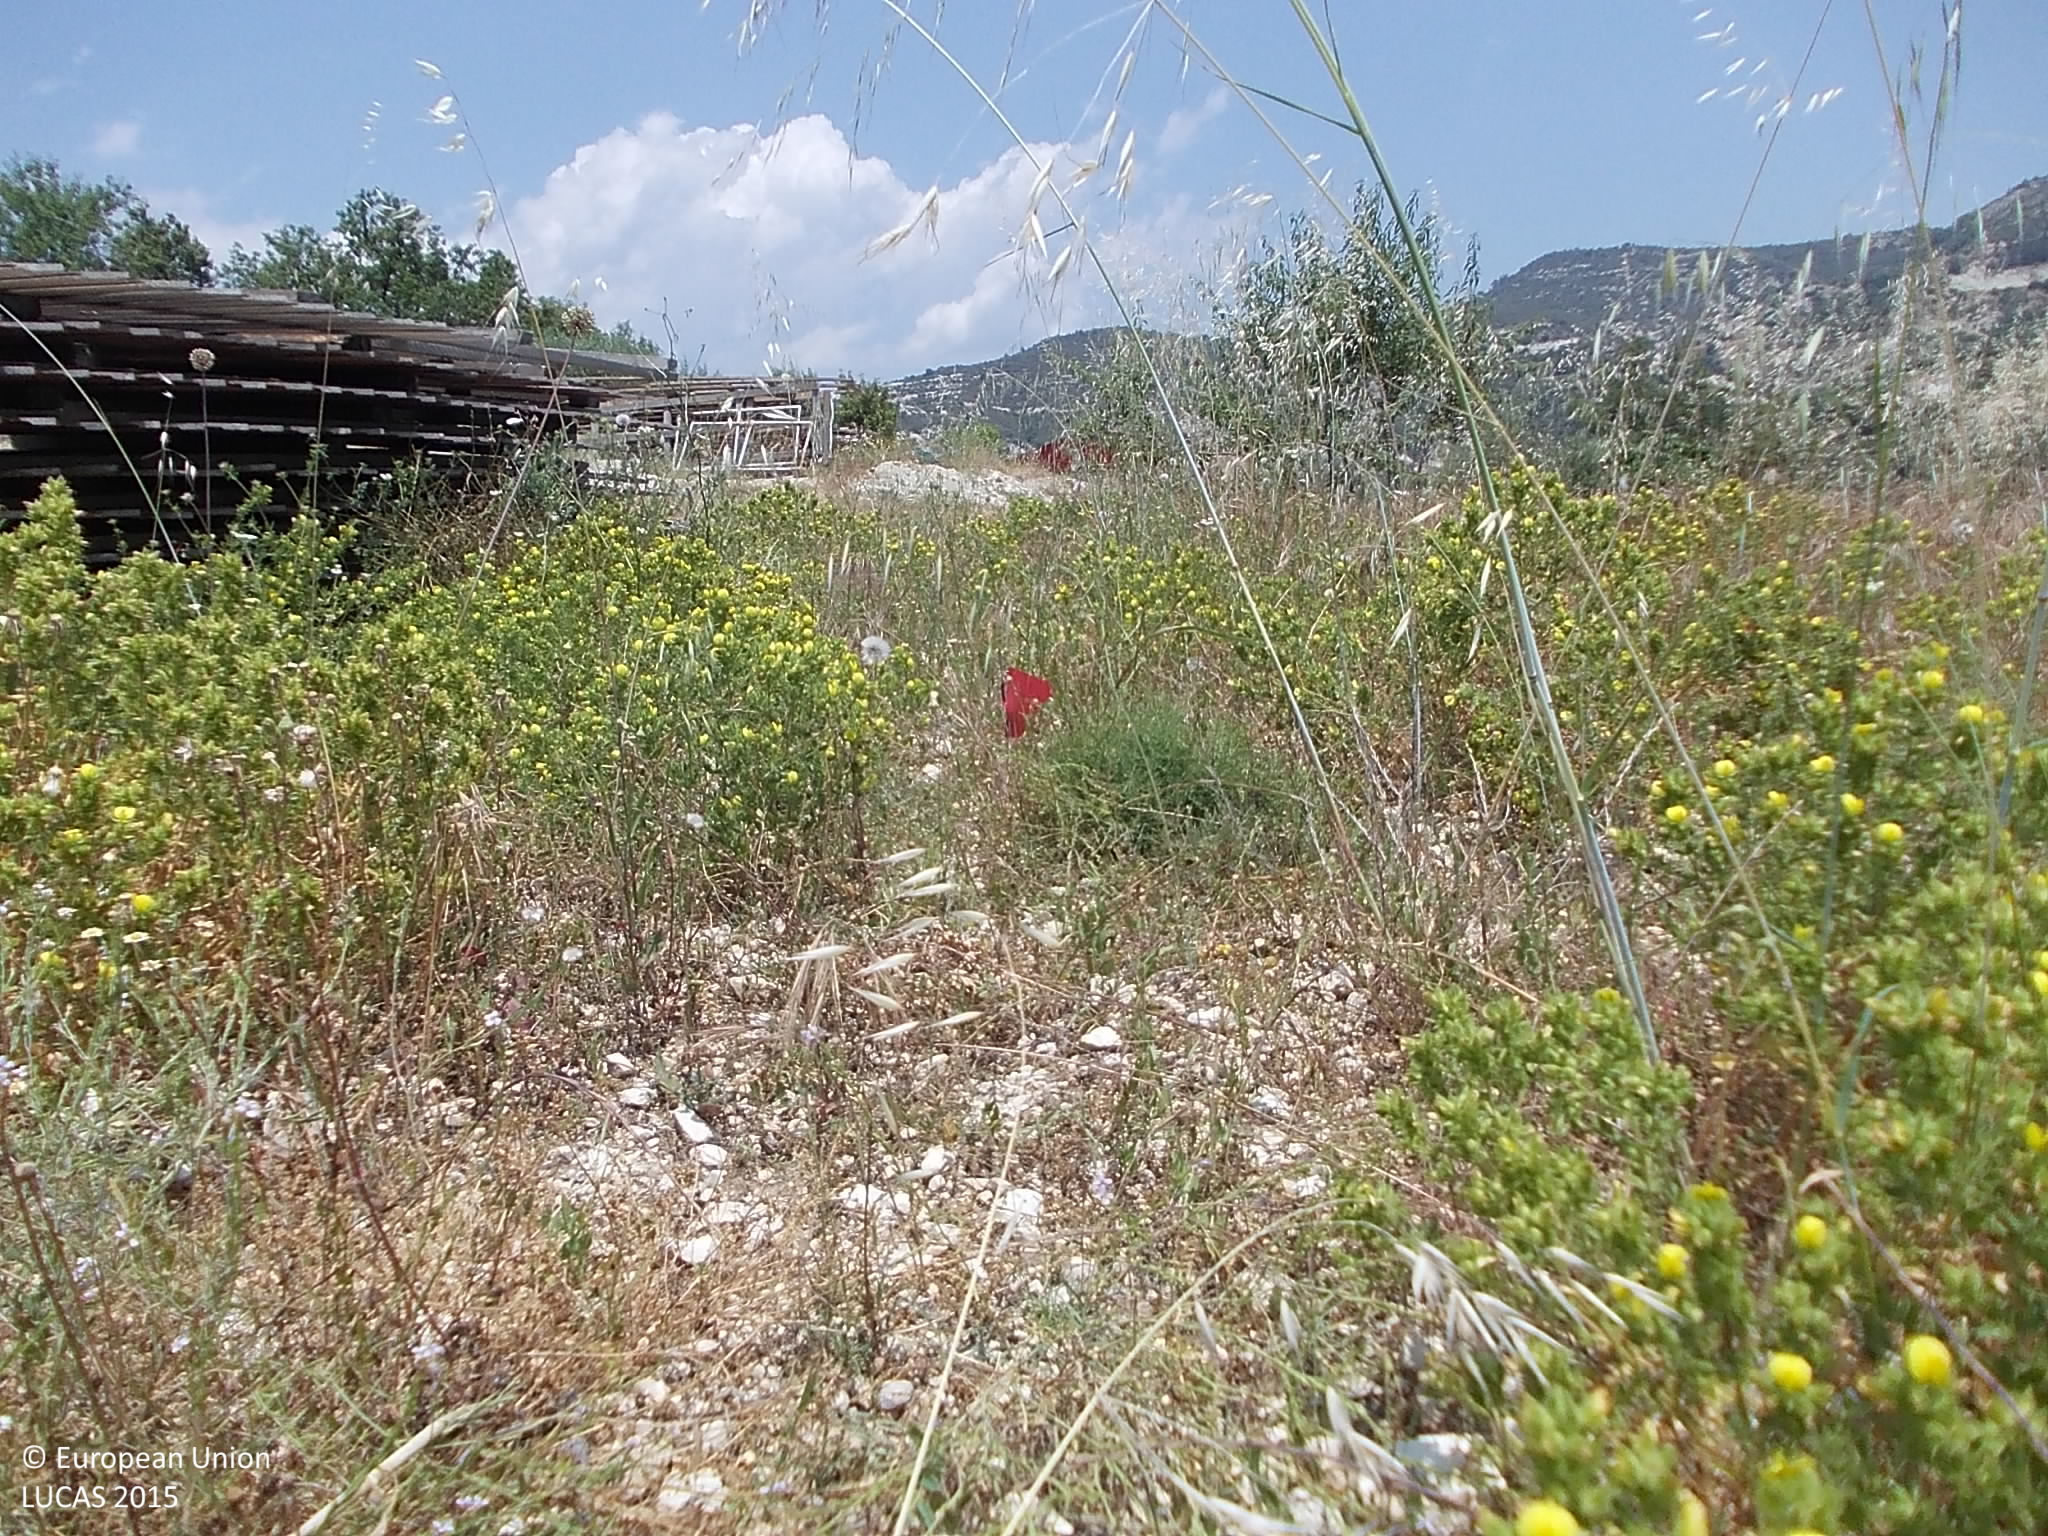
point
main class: Grassland
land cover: Grassland without tree/shrub cover
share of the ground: > 75 %
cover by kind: herbaceous plants 95 %, unconsolidated bare surface 5 %
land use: Semi-natural and natural areas not in use
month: May
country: CY
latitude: 34.8051
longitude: 32.9566
